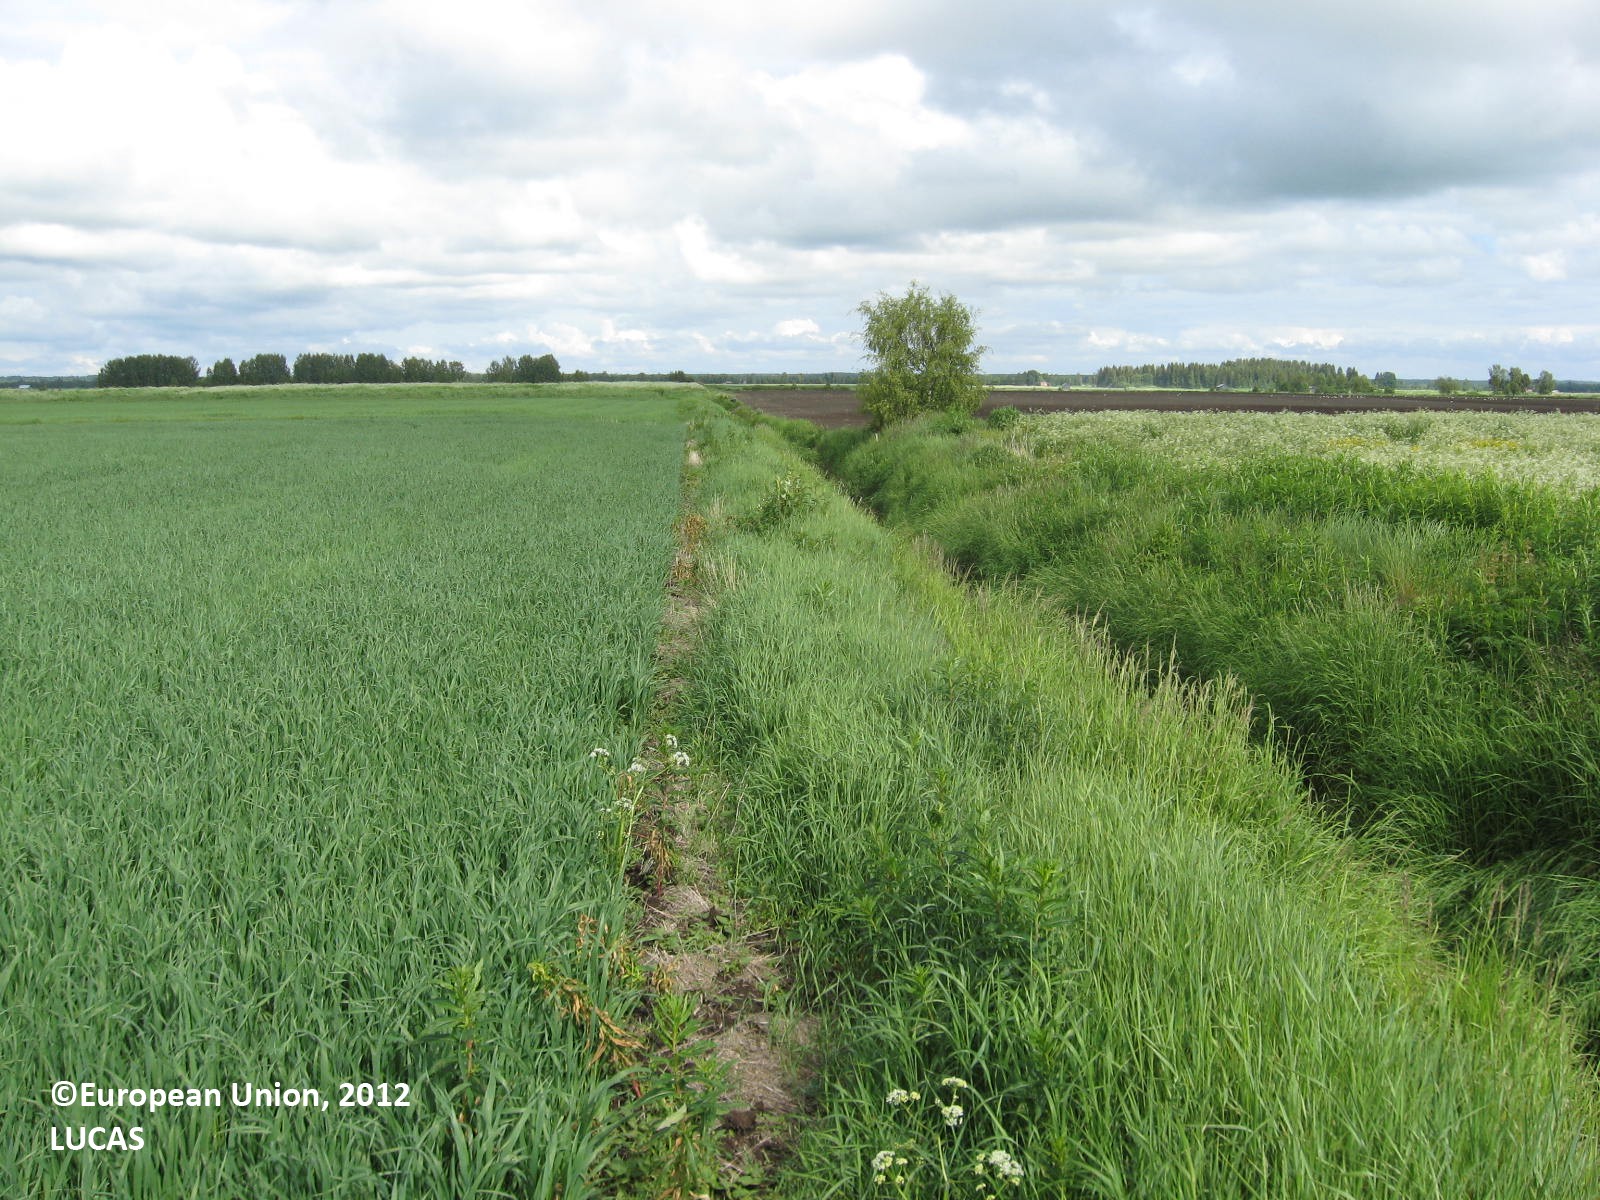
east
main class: Cropland
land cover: Oats
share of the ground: > 75 %
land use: Agriculture (excluding fallow land and kitchen gardens)
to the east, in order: Oats; Grass margins; Ditches and canals; Grass margins; Grassland without tree/shrub cover; Ditches and canals
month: June
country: FI
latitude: 63.0271
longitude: 22.8822
